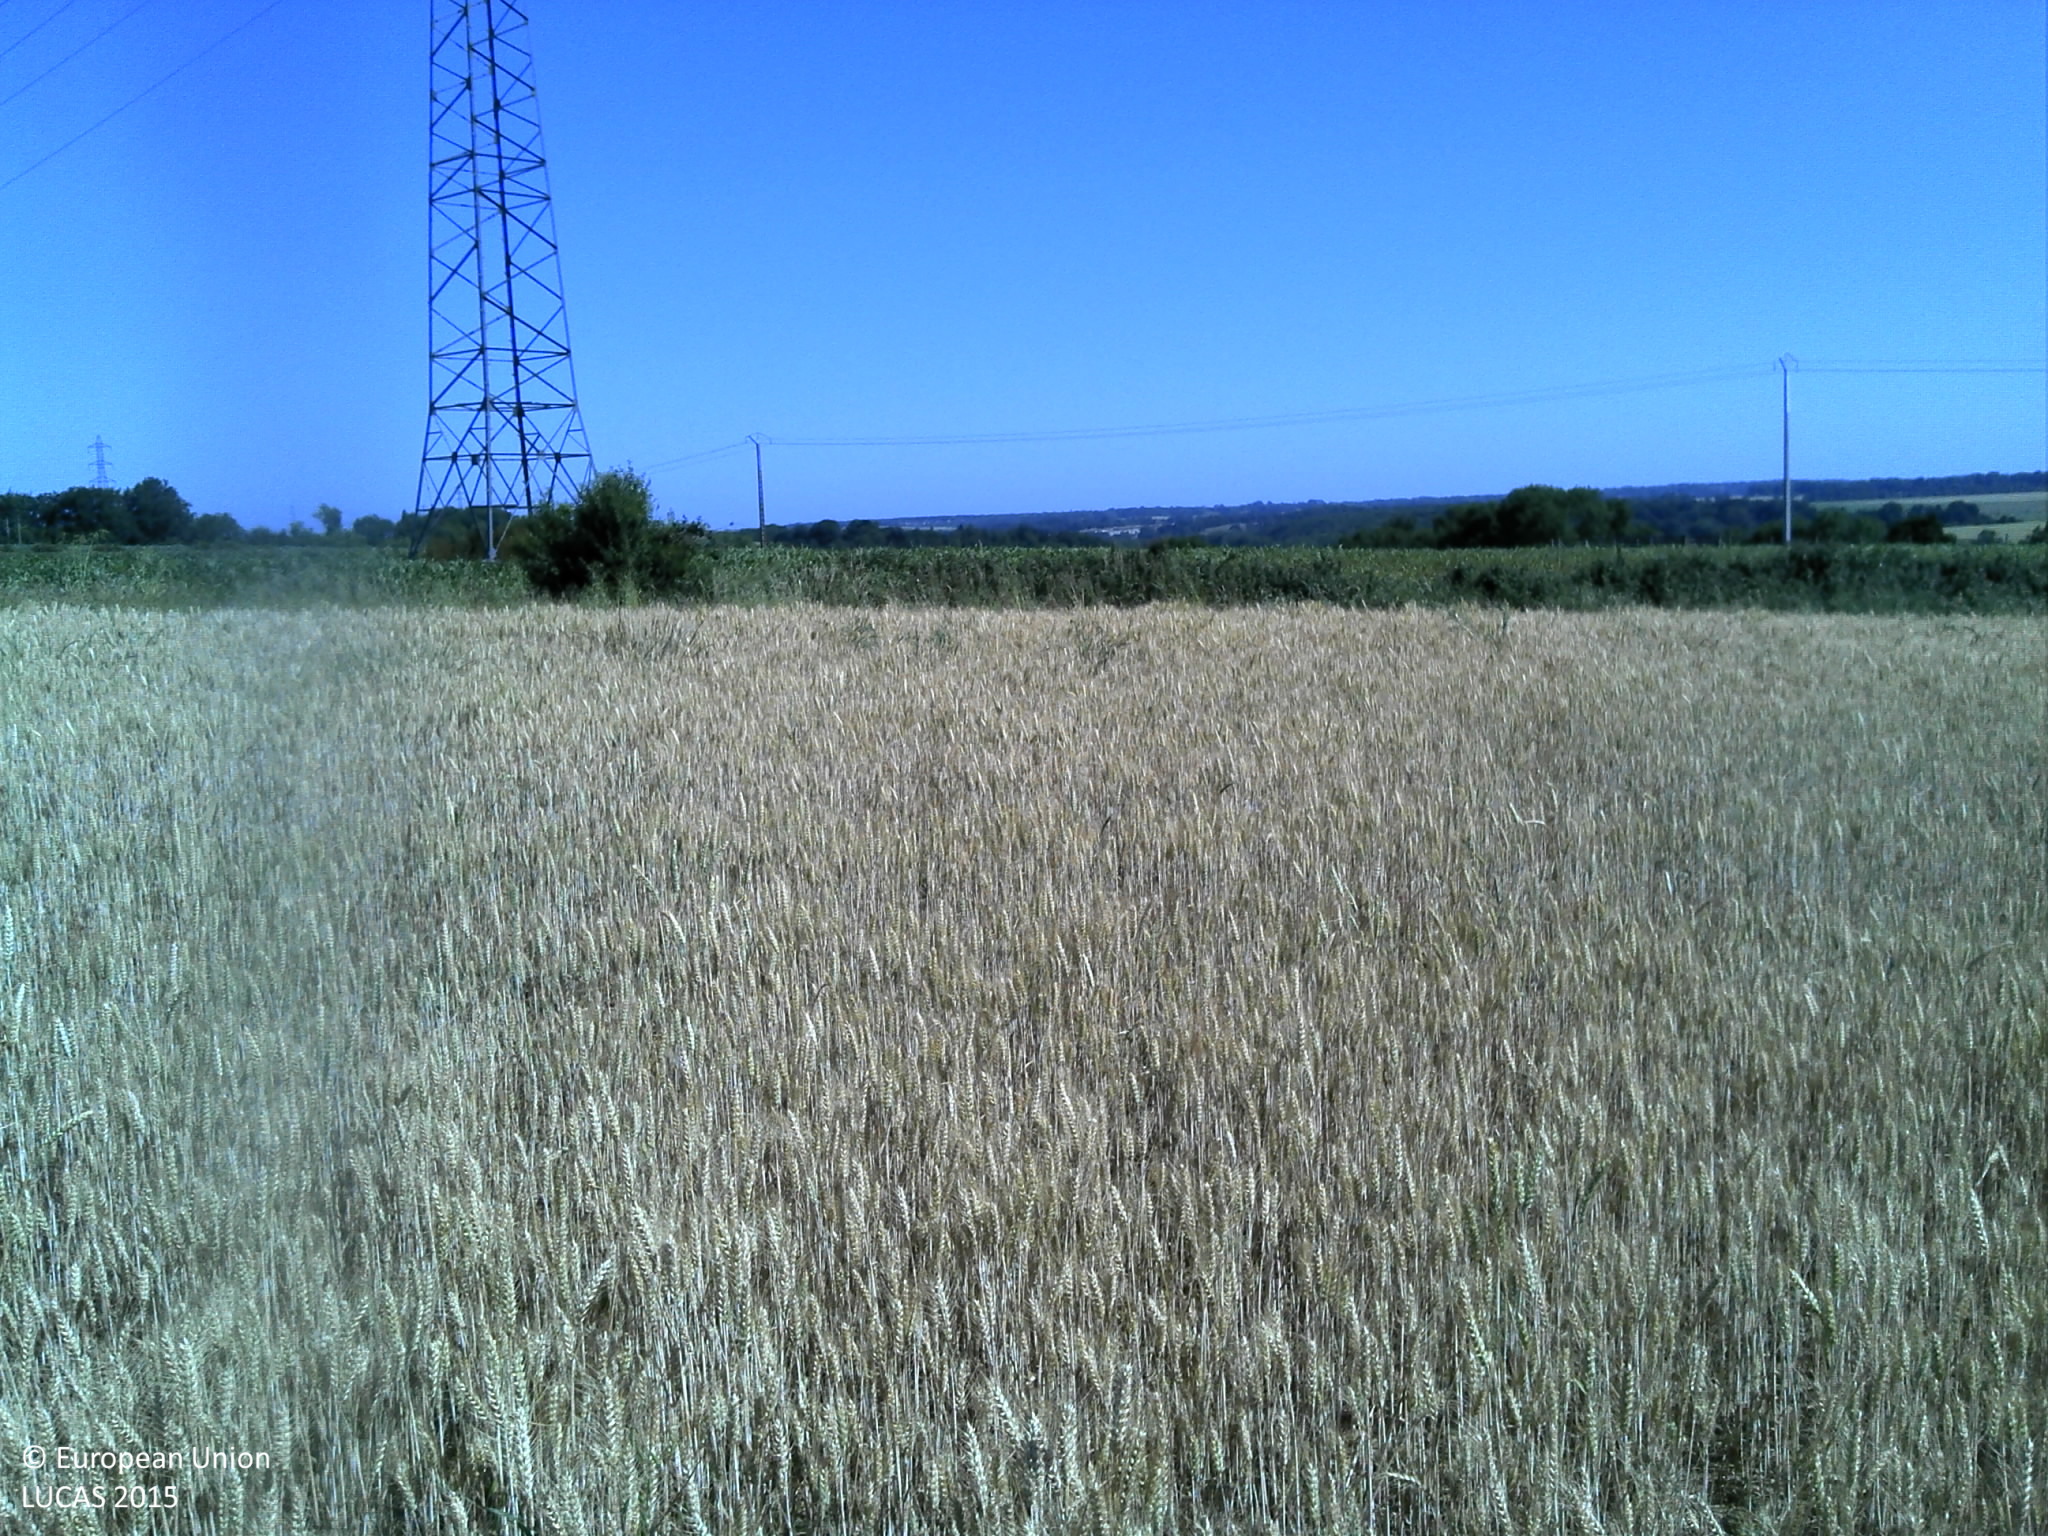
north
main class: Cropland
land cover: Durum wheat
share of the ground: > 75 %
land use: Agriculture (excluding fallow land and kitchen gardens)
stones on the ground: 10 - 25 %
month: June
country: FR
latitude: 49.8420
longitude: 0.9523
